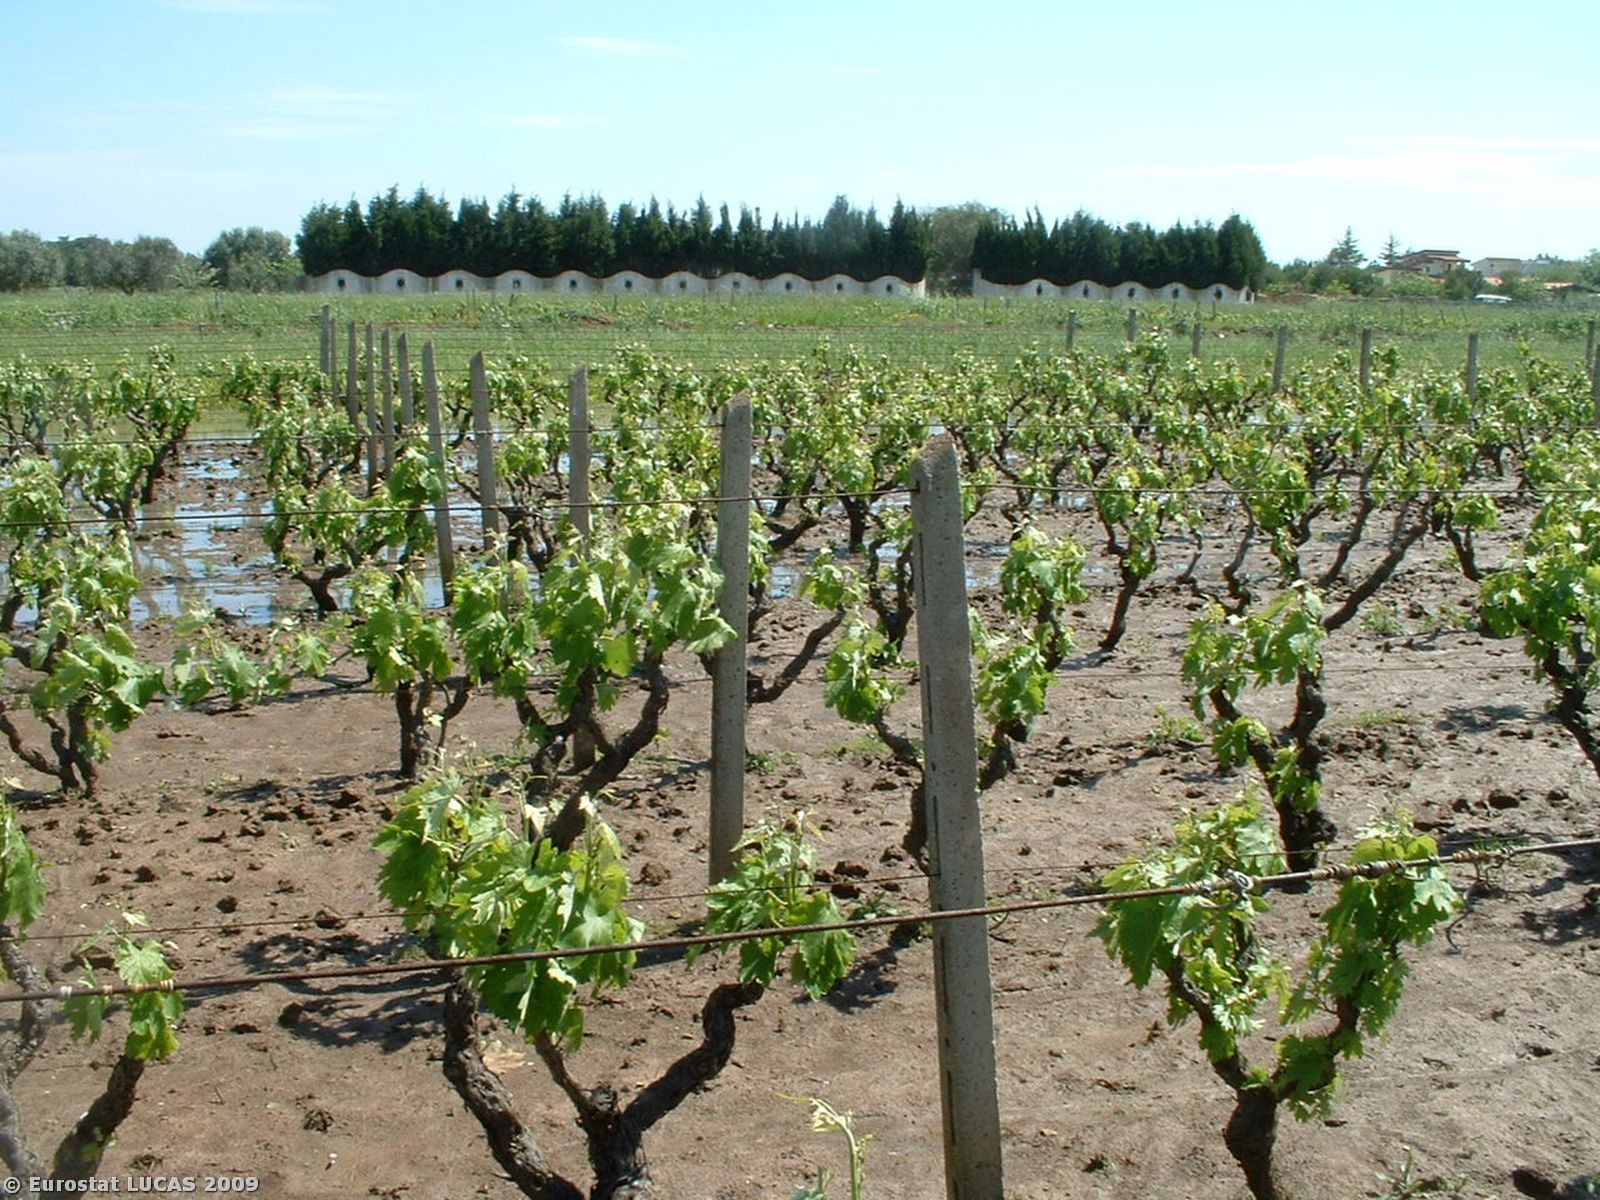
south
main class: Cropland
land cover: Vineyards
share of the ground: 50 - 75 %
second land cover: Bare land
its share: > 75 %
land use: Agriculture (excluding fallow land and kitchen gardens)
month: April
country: IT
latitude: 40.0594
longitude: 18.0975
